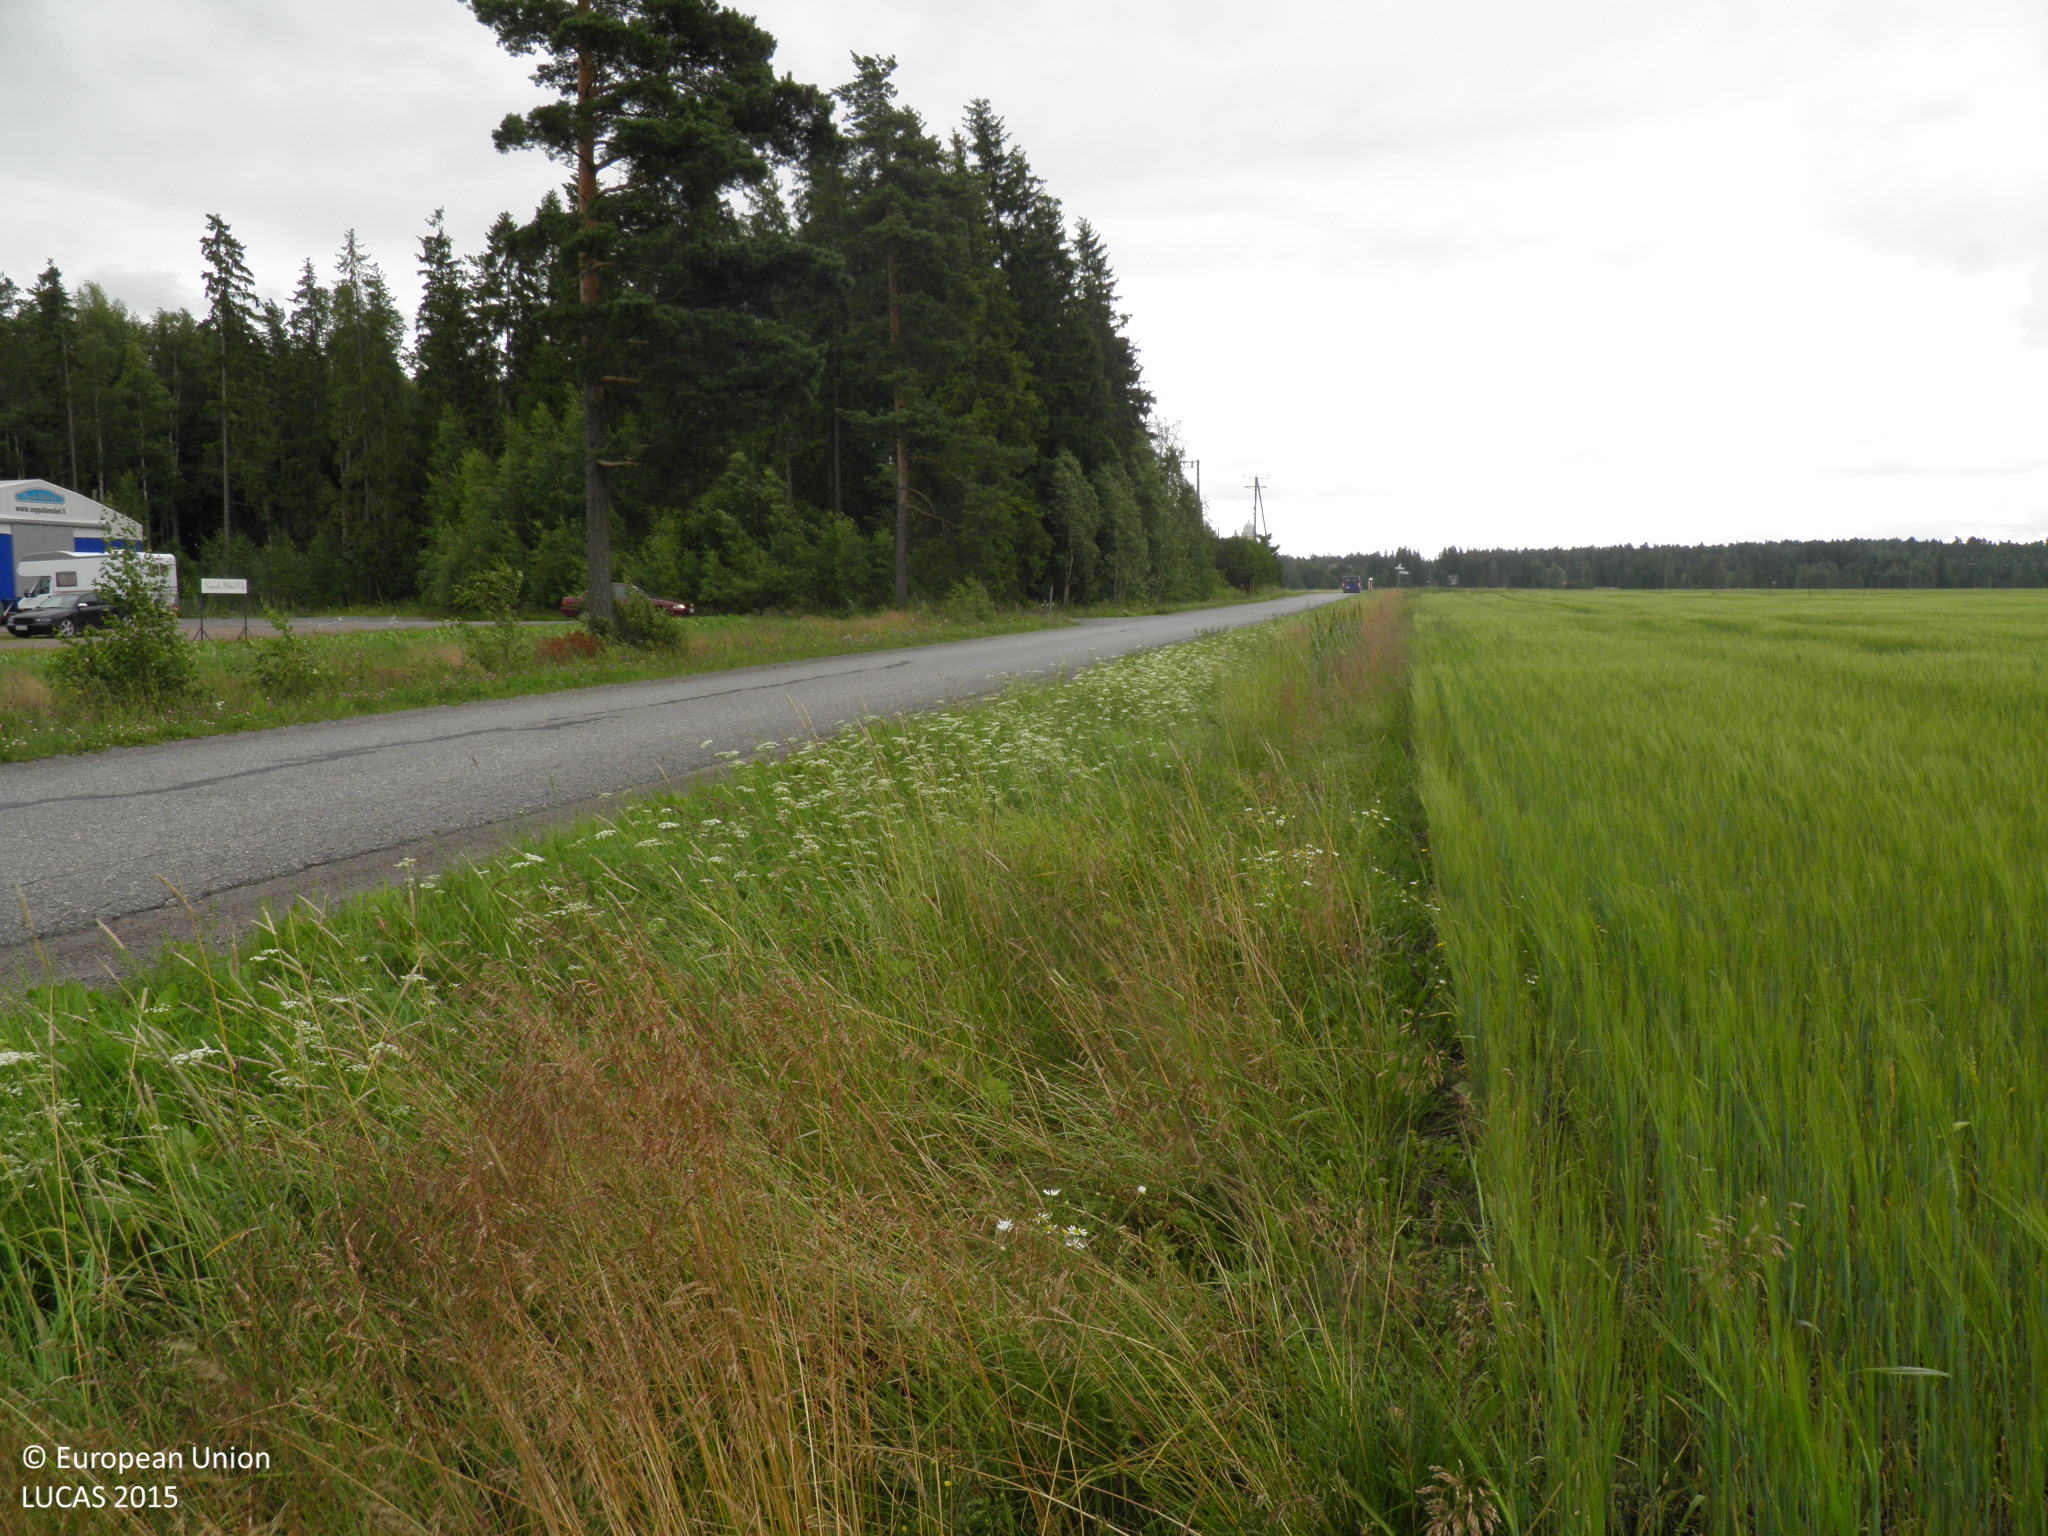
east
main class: Cropland
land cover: Barley
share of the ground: > 75 %
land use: Agriculture (excluding fallow land and kitchen gardens)
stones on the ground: < 10 %
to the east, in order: Barley; Grass margins; Ditches and canals; Grass margins; Paved roads, cycling and walking lanes; Grass margins; Ditches and canals; Spruce dominated mixed woodland; Artificial constructions in urban areas; Dry pulses; Lines of trees; Tracks; Grass margins
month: July
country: FI
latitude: 60.8786
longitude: 22.9507
